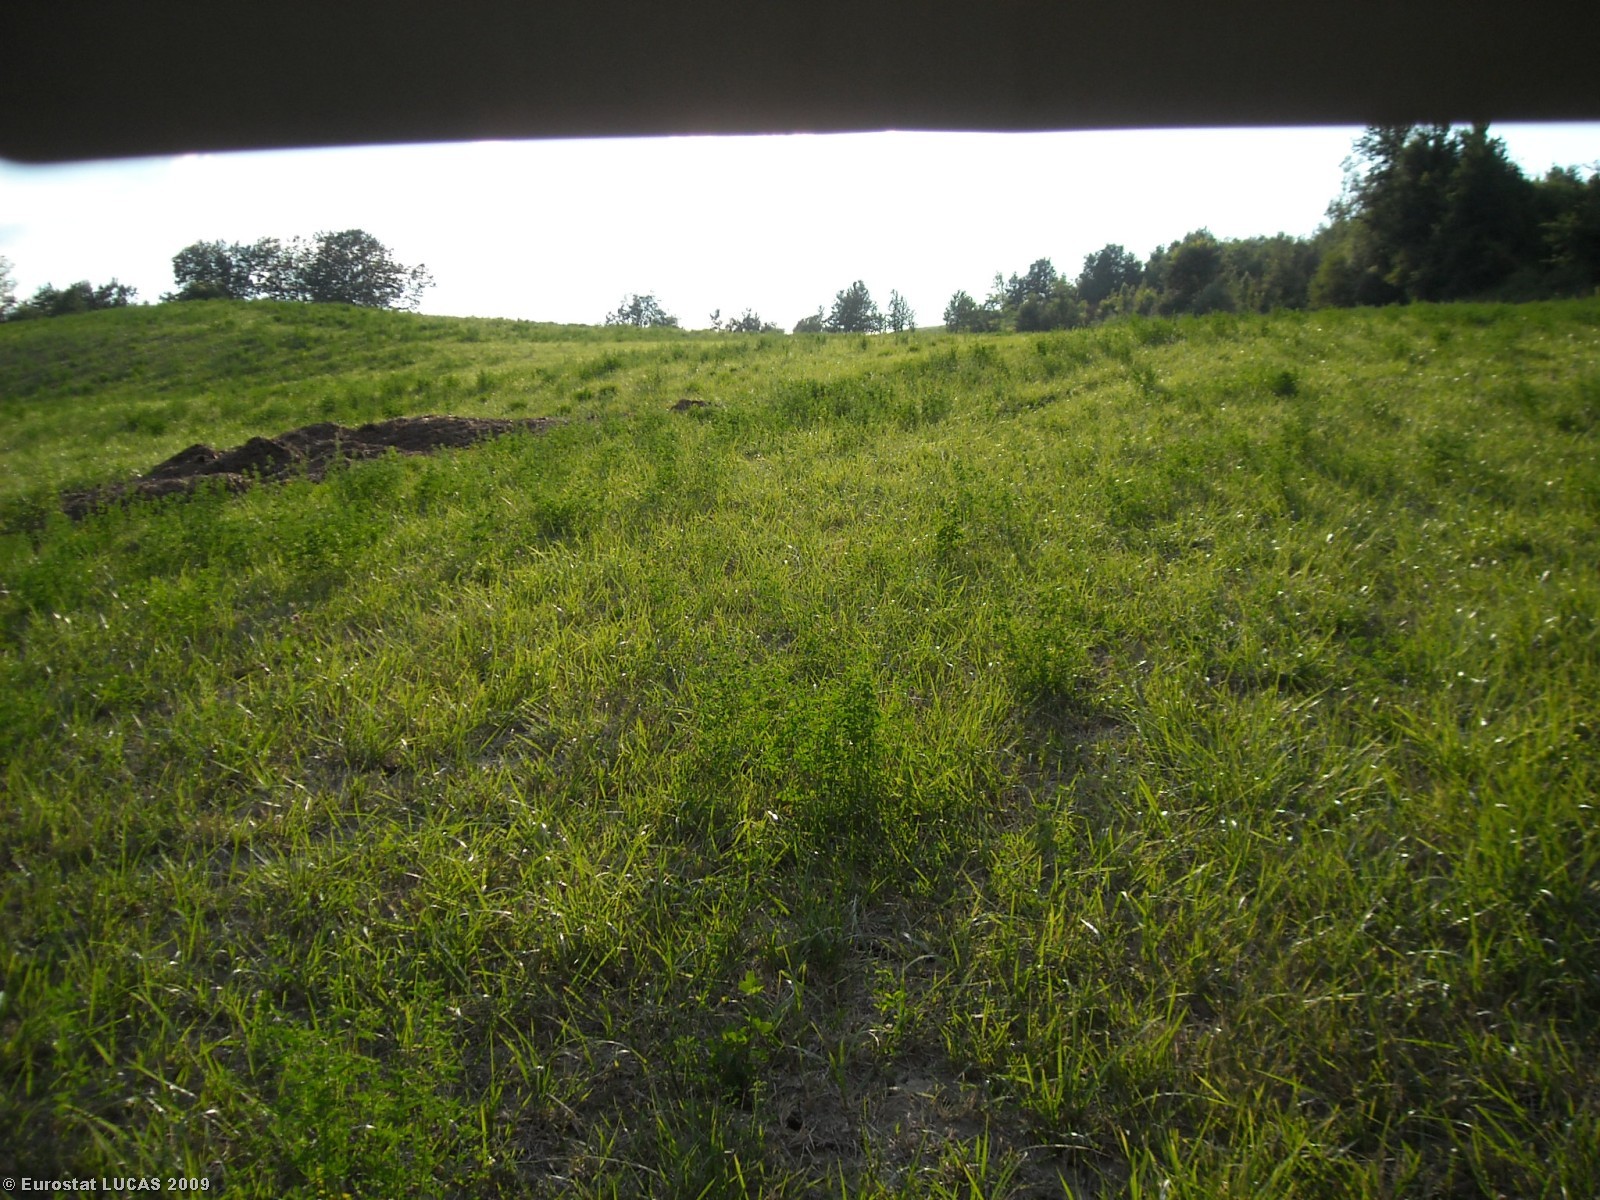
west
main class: Grassland
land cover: Grassland without tree/shrub cover
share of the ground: > 75 %
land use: Agriculture (excluding fallow land and kitchen gardens)
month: June
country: IT
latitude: 45.1264
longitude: 8.0836
